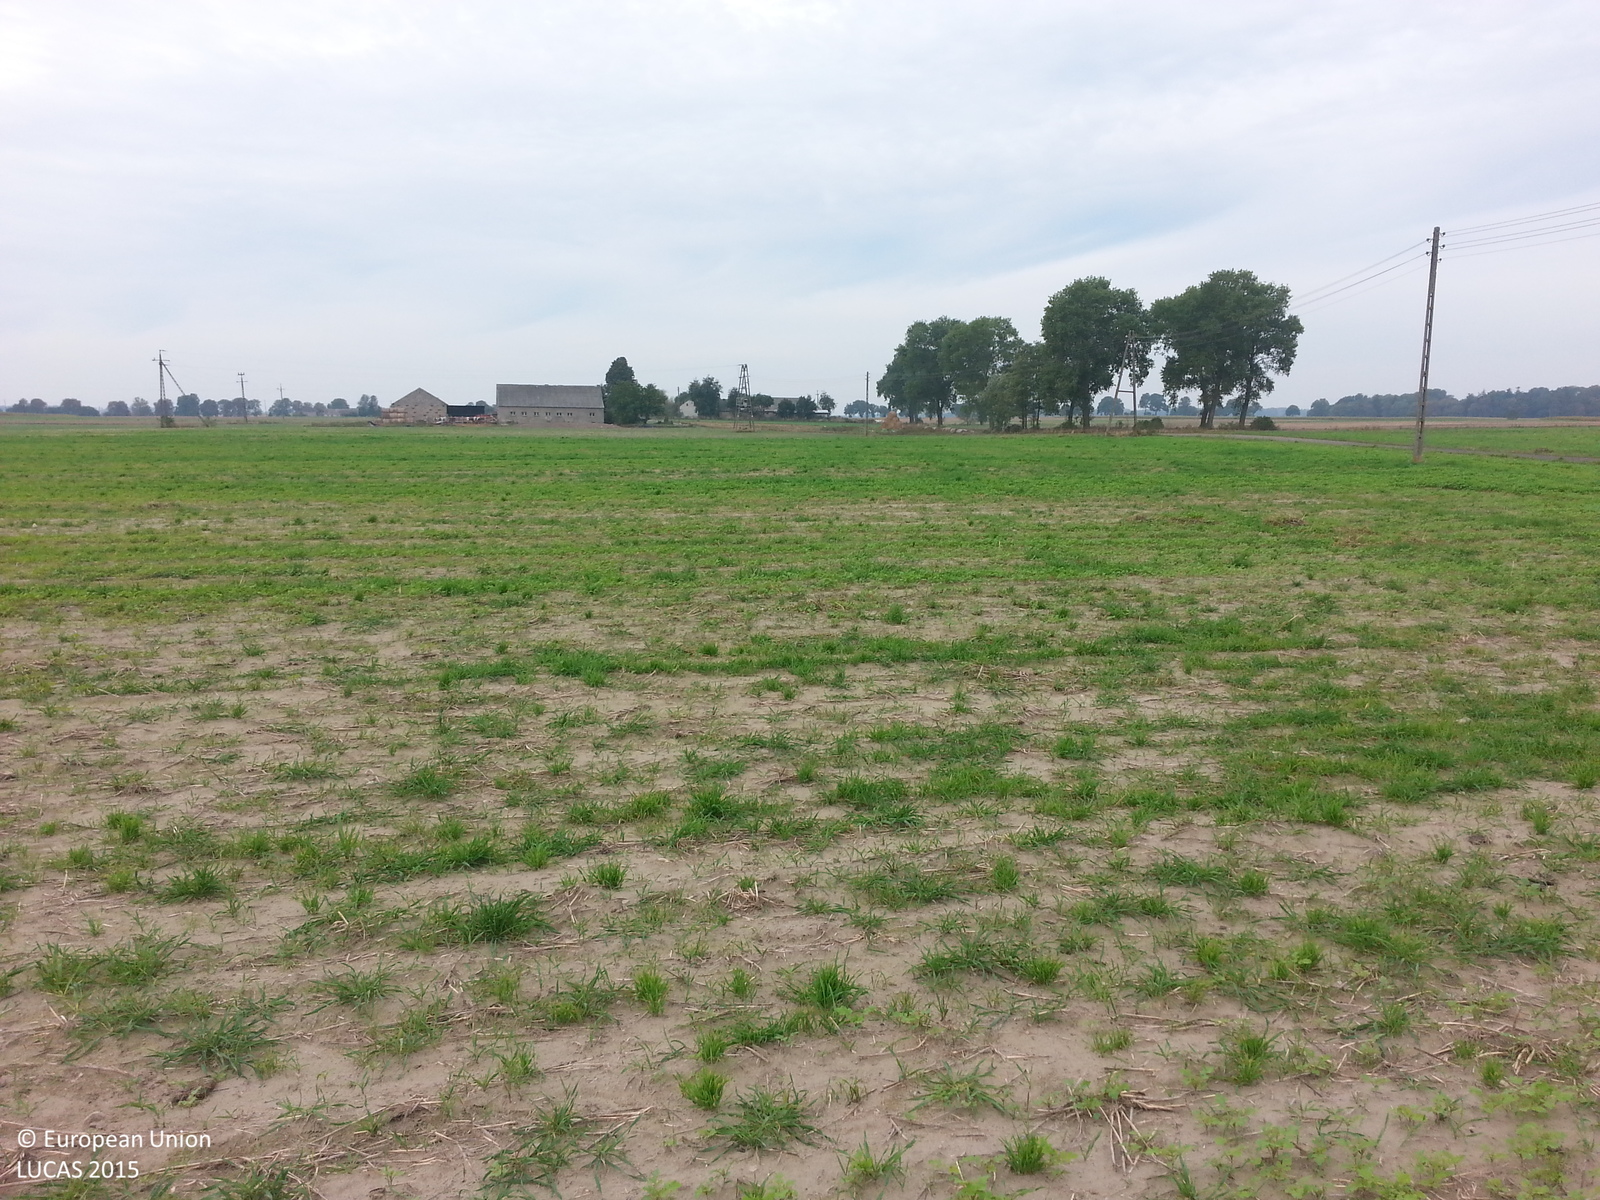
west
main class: Cropland
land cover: Common wheat
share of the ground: 10 - 25 %
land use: Agriculture (excluding fallow land and kitchen gardens)
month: September
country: PL
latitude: 53.3780
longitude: 18.1786
